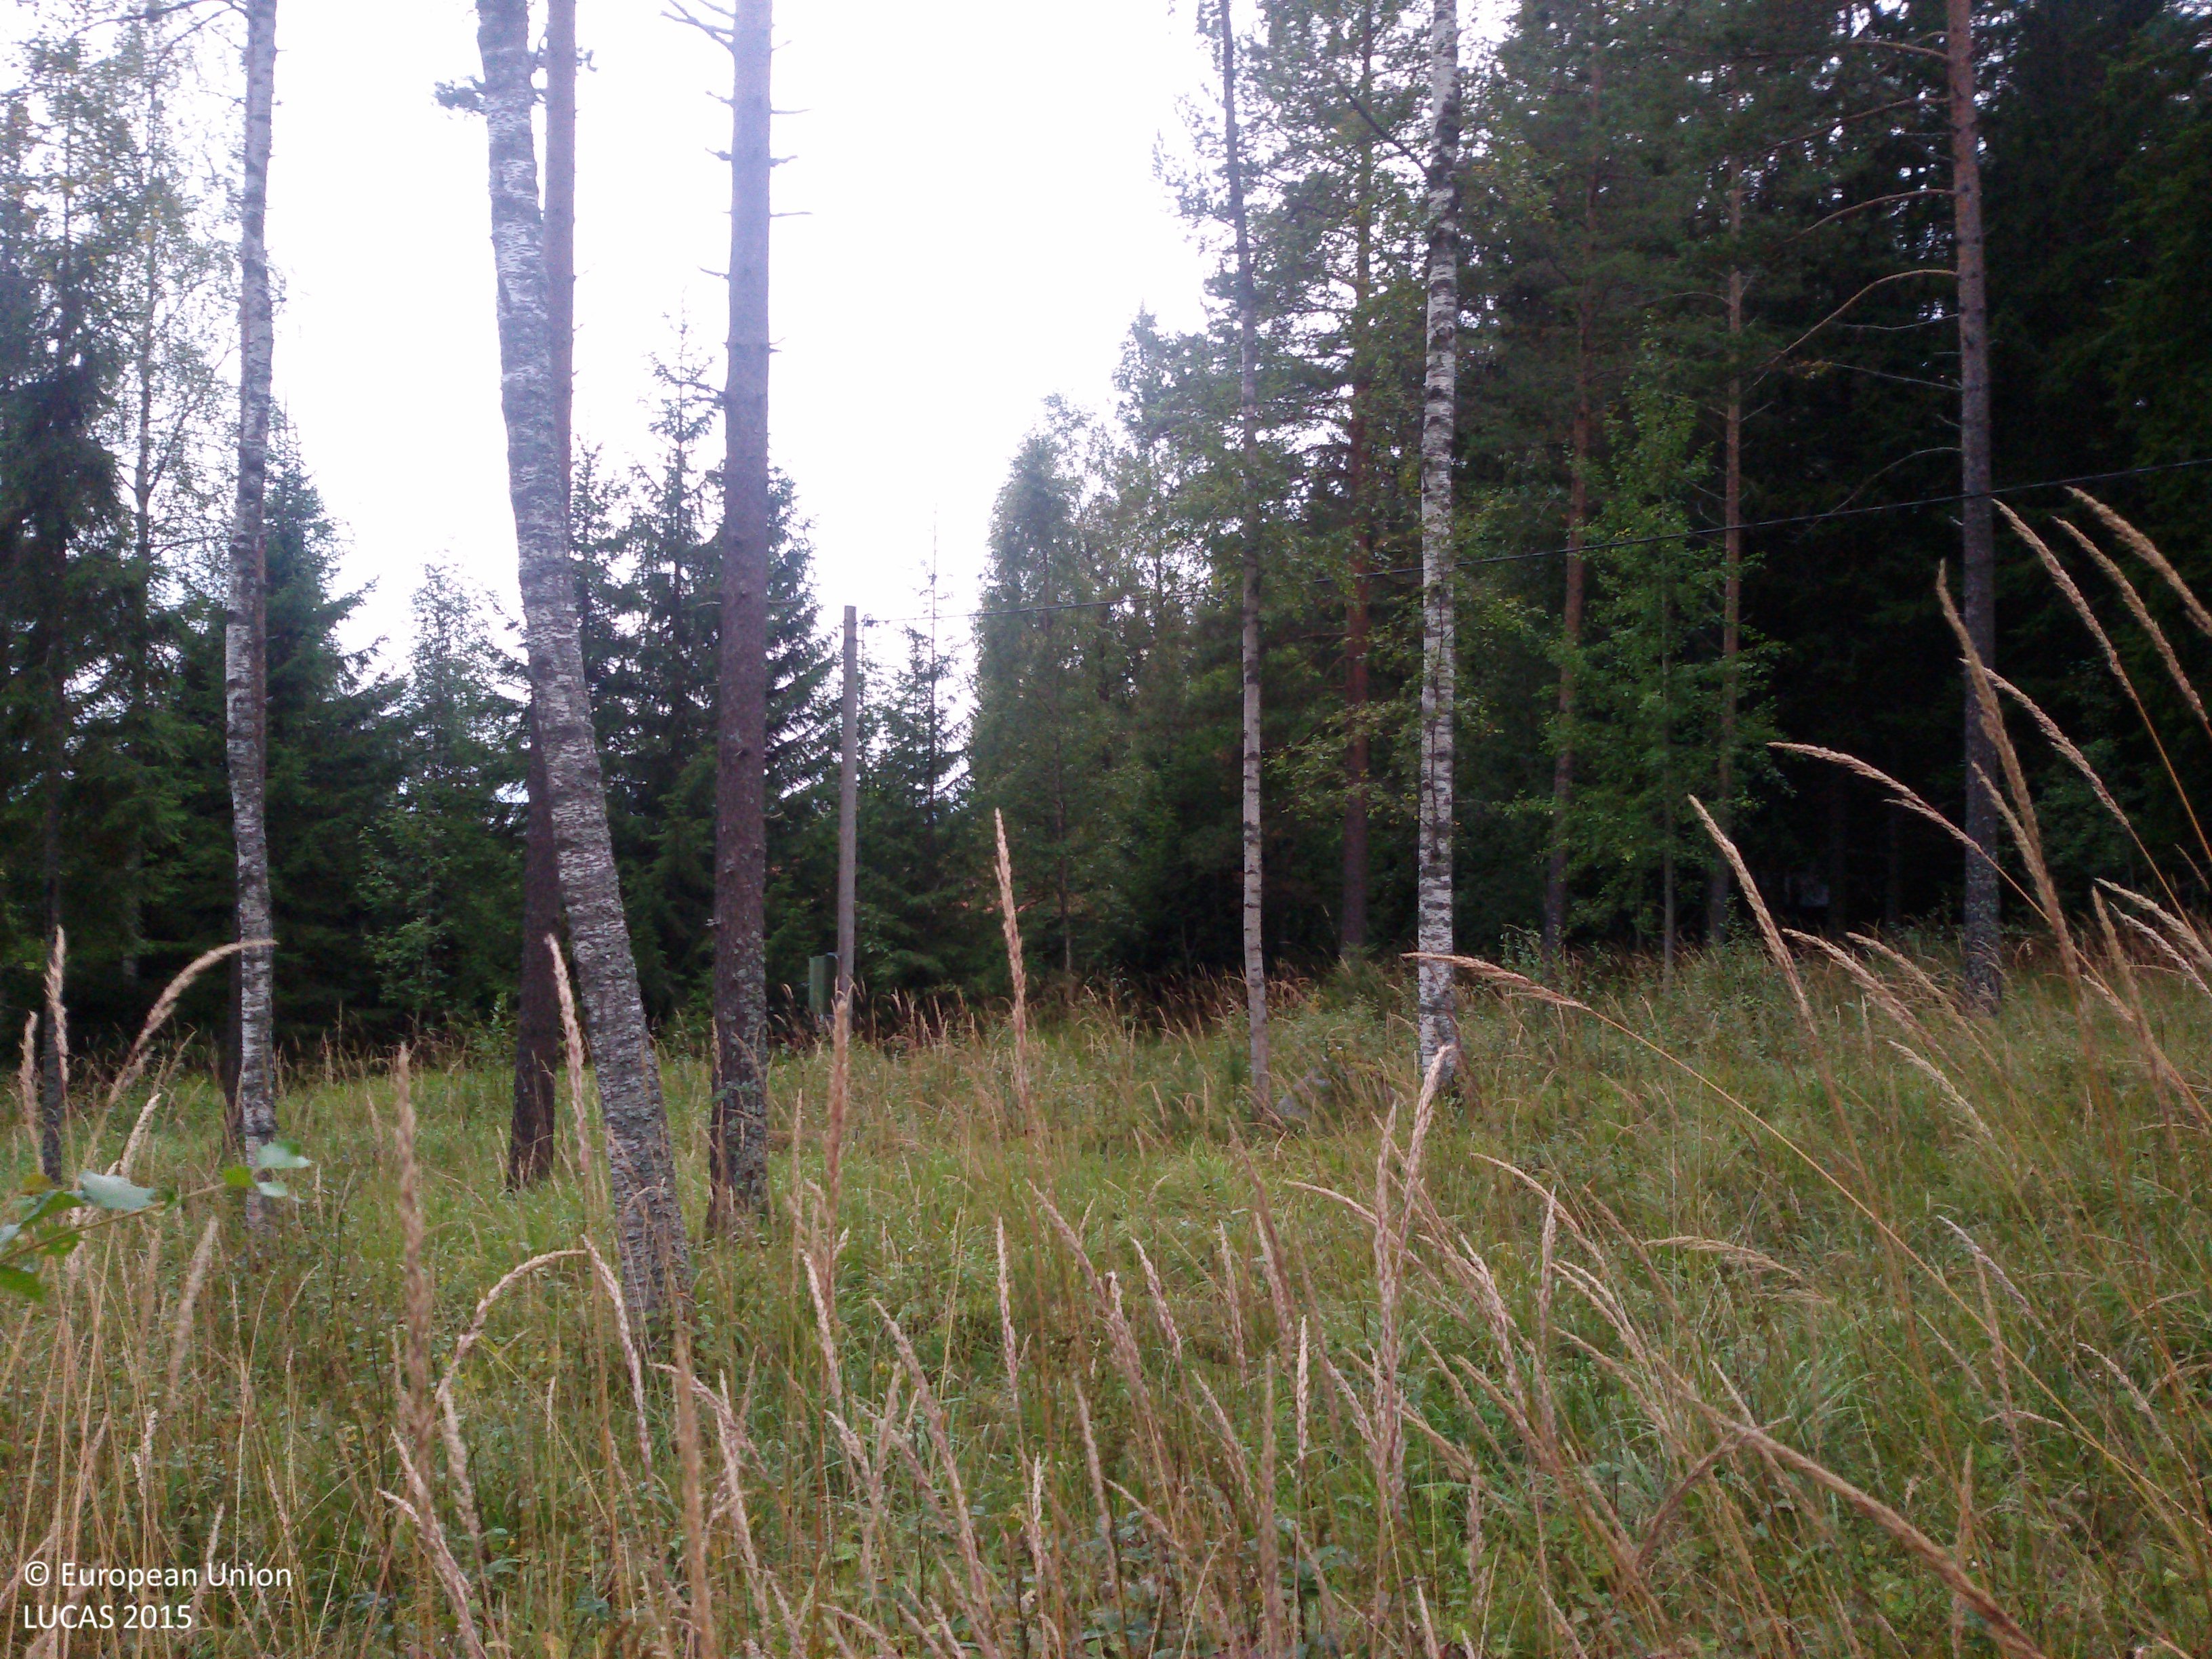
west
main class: Woodland
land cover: Pine dominated mixed woodland
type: boreal forest
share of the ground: 25 - 50 %
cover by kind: herbaceous plants 70 %, coniferous forest trees 15 %, broadleaved forest trees 15 %
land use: Forestry
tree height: > 5 m
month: September
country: SE
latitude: 60.8184
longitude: 15.3737
